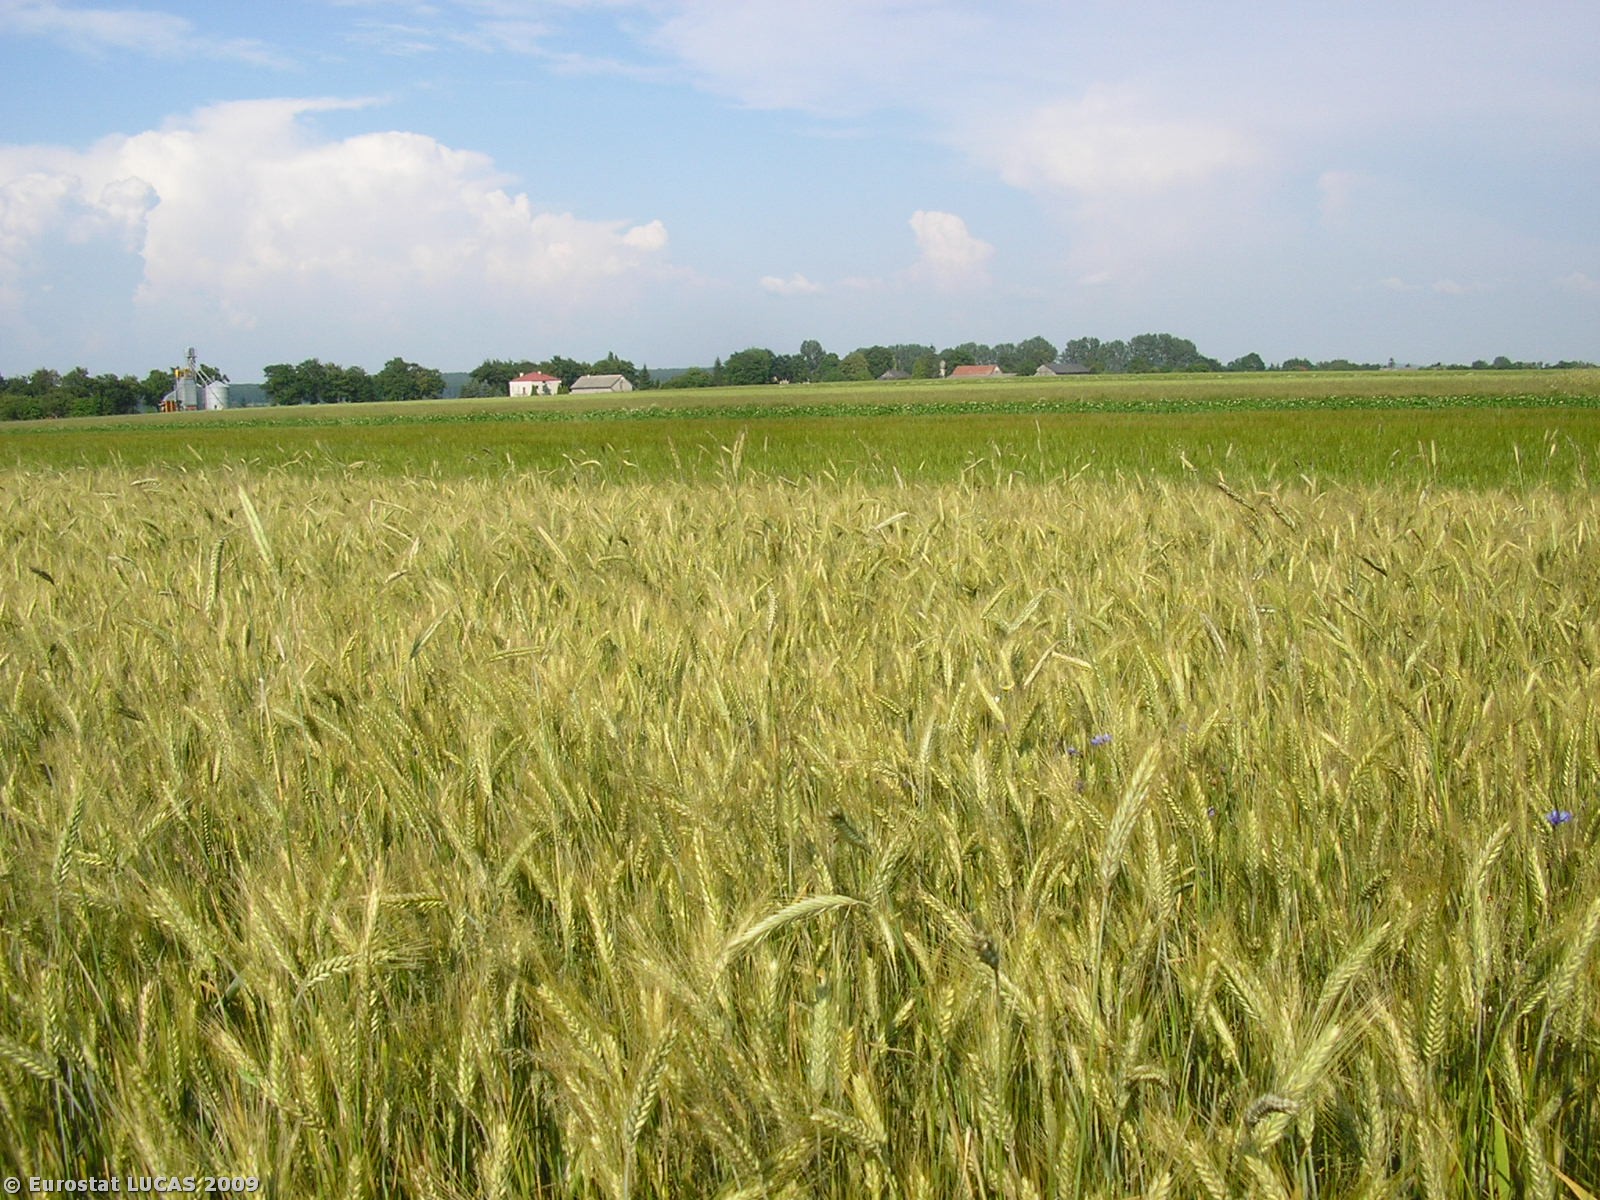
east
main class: Cropland
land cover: Triticale
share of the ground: > 75 %
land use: Agriculture (excluding fallow land and kitchen gardens)
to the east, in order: Triticale; Barley; Grass margins; Maize; Potatoes; Grass margins; Common wheat; Grass margins; Common wheat; Grass margins; Maize; Grass margins; Barley
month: June
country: PL
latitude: 50.4616
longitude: 20.0773
